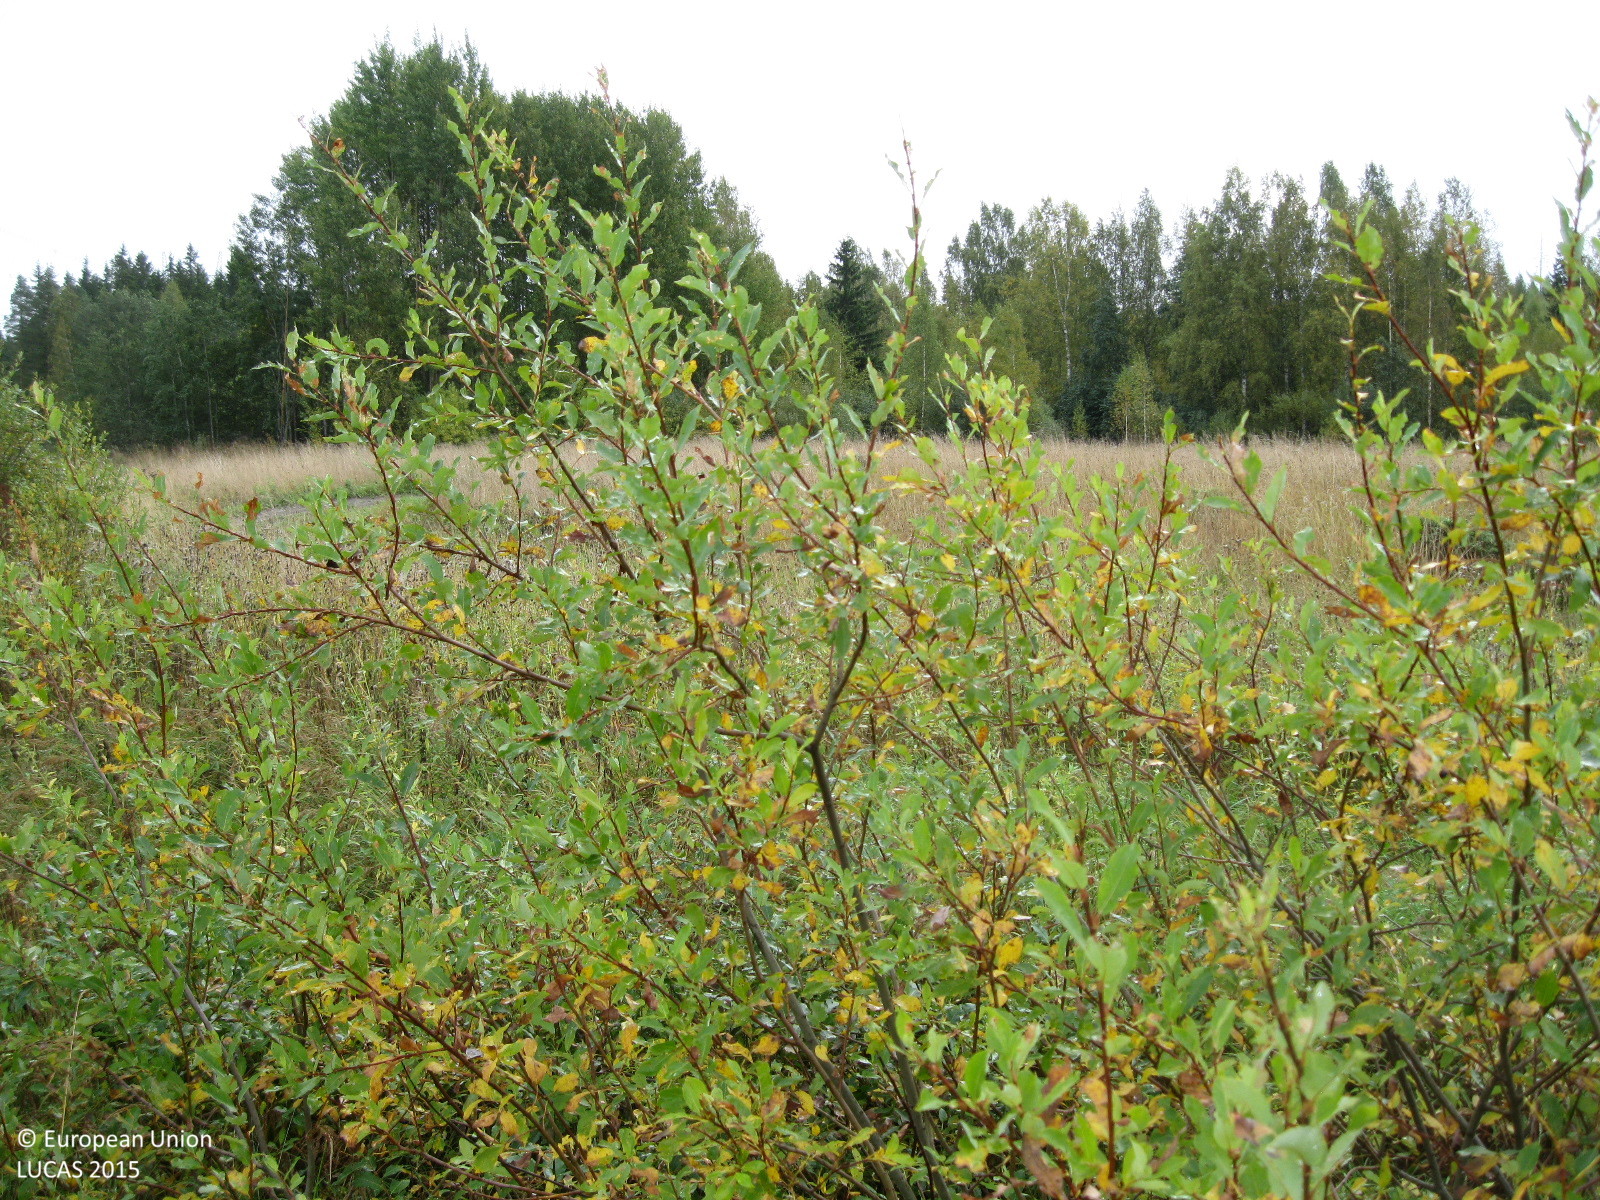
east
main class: Grassland
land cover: Spontaneously vegetated surfaces
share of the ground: > 75 %
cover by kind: herbaceous plants 100 %
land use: Sport
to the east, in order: Spontaneously vegetated surfaces; Tracks; Spontaneously vegetated surfaces; Broadleaved woodland; Spruce dominated mixed woodland; Broadleaved woodland
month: September
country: FI
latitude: 60.7698
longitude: 24.8161
